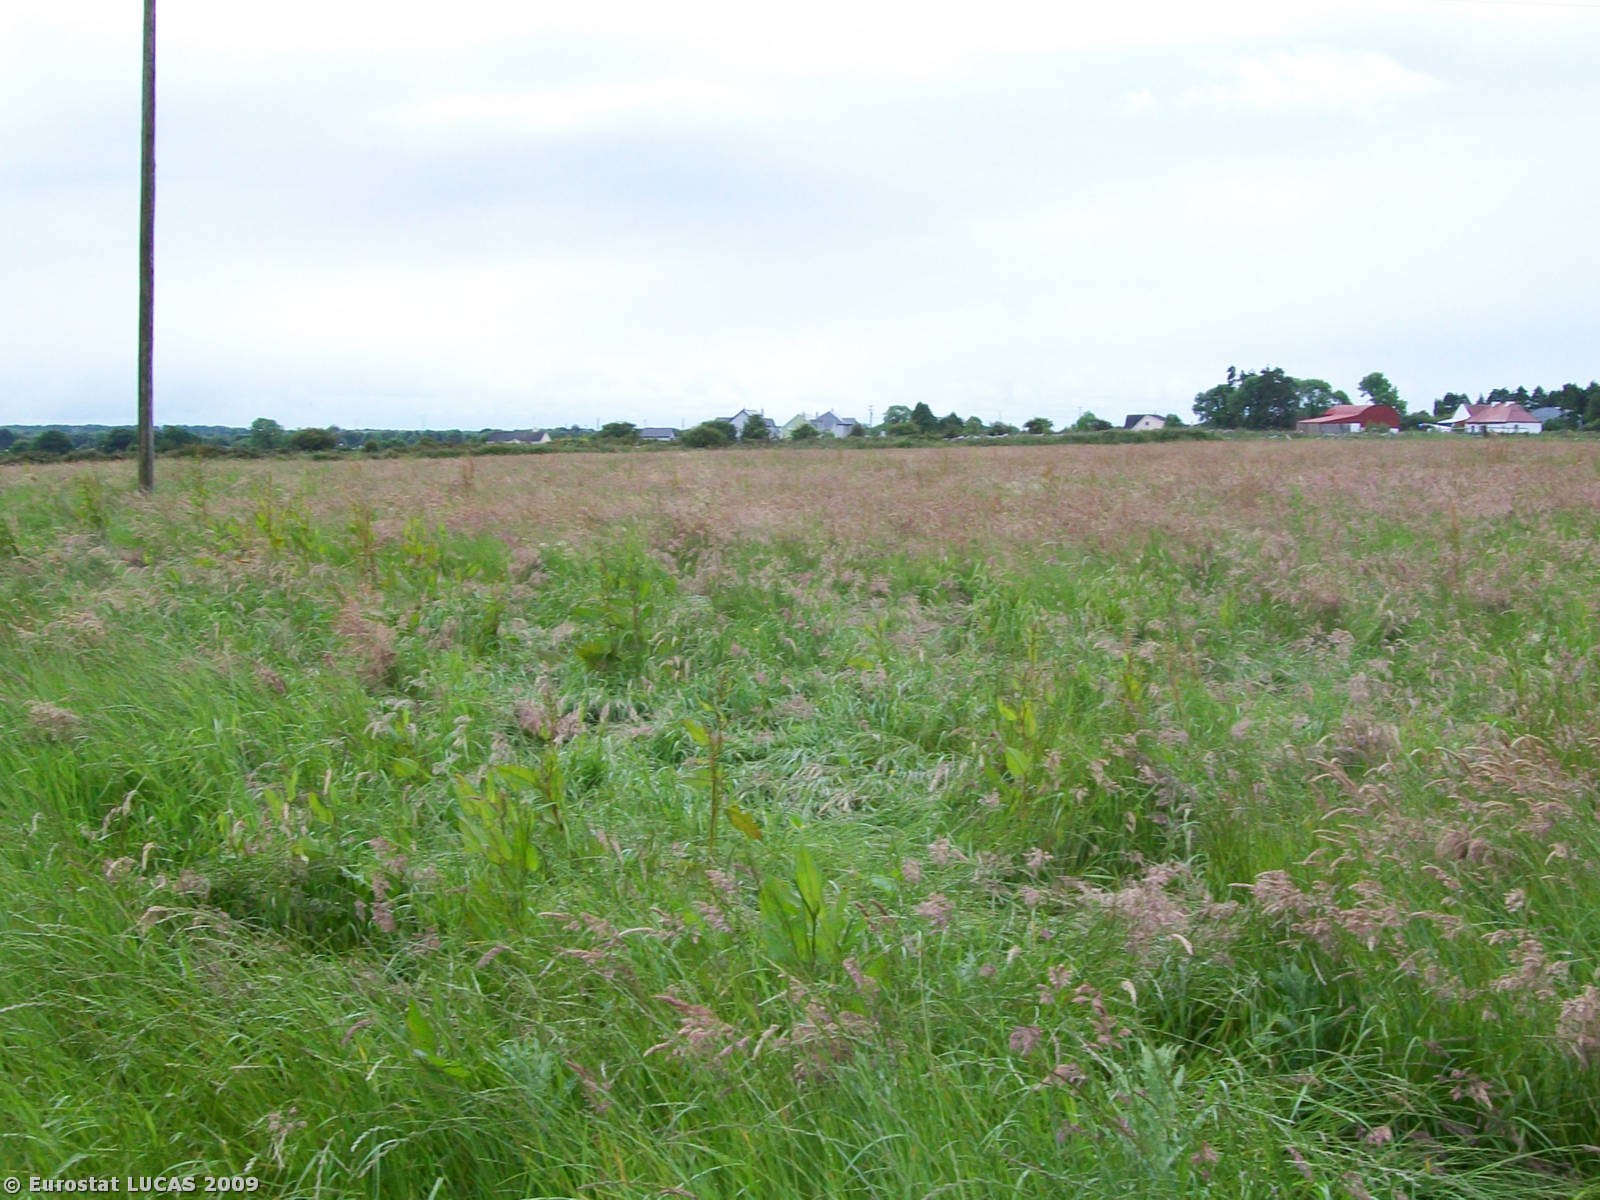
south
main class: Grassland
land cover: Grassland without tree/shrub cover
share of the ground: > 75 %
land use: Agriculture (excluding fallow land and kitchen gardens)
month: June
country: IE
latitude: 53.3838
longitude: -8.8336
